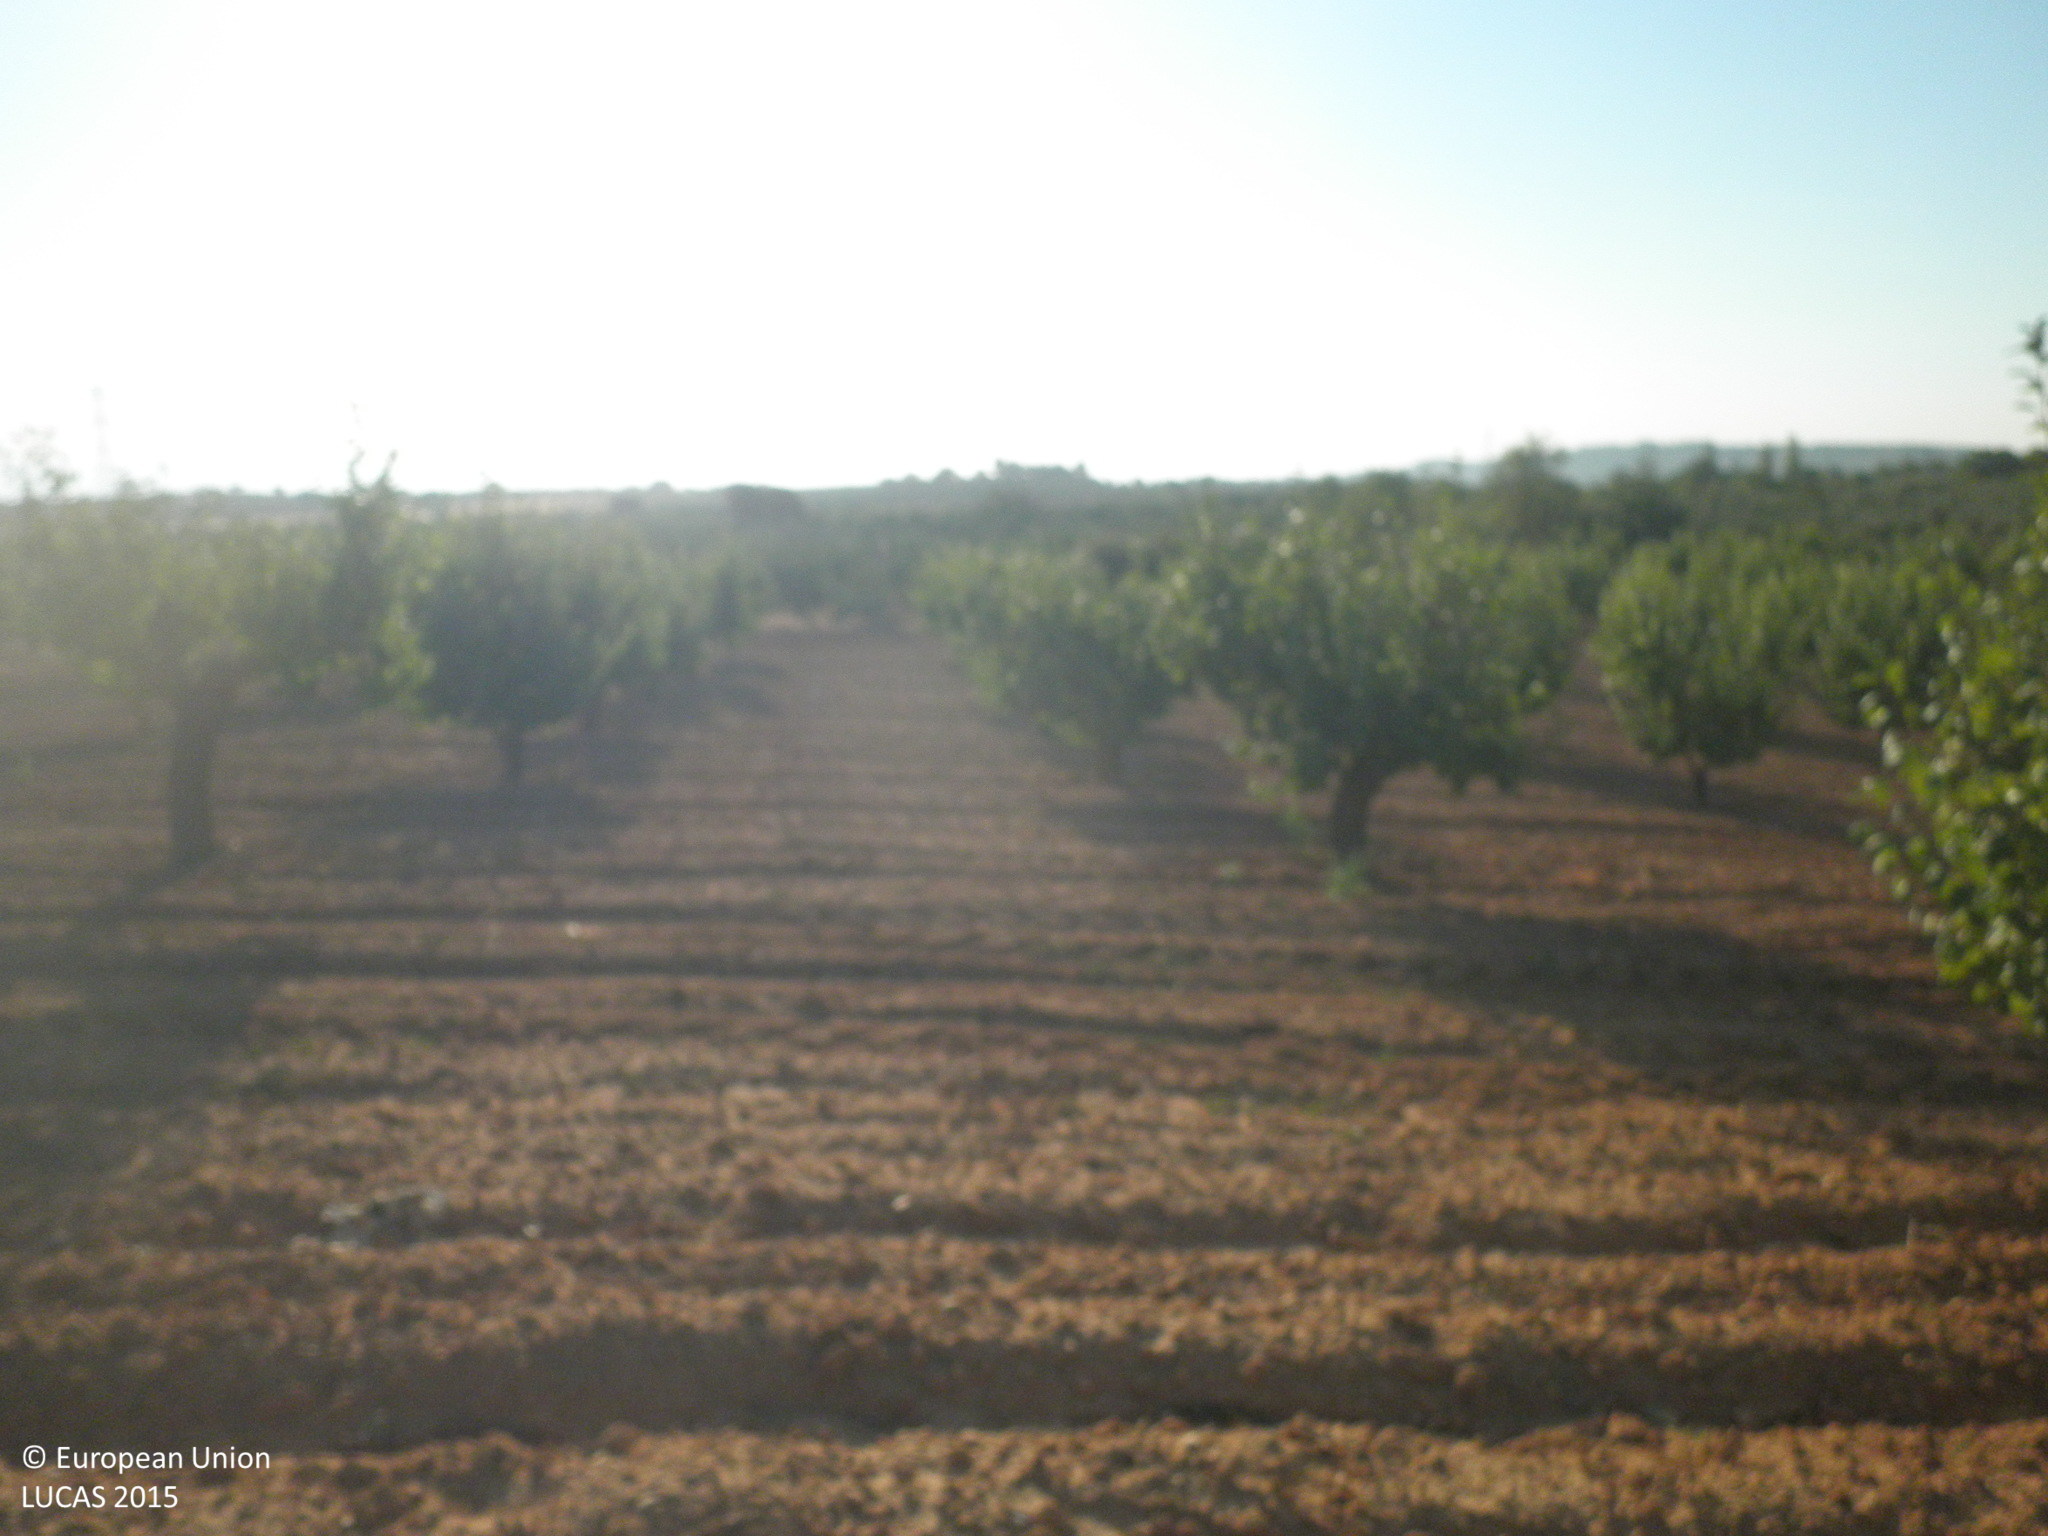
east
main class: Cropland
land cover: Other fruit trees and berries
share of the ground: 10 - 25 %
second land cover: Other bare soil
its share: > 75 %
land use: Agriculture (excluding fallow land and kitchen gardens)
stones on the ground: < 10 %
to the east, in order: Other fruit trees and berries; Other bare soil; Shruby margins; Olive groves; Grass margins; Olive groves; Grass margins; Olive groves; Tracks; Grass margins; Olive groves
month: July
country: ES
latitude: 39.3786
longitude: -1.5771
